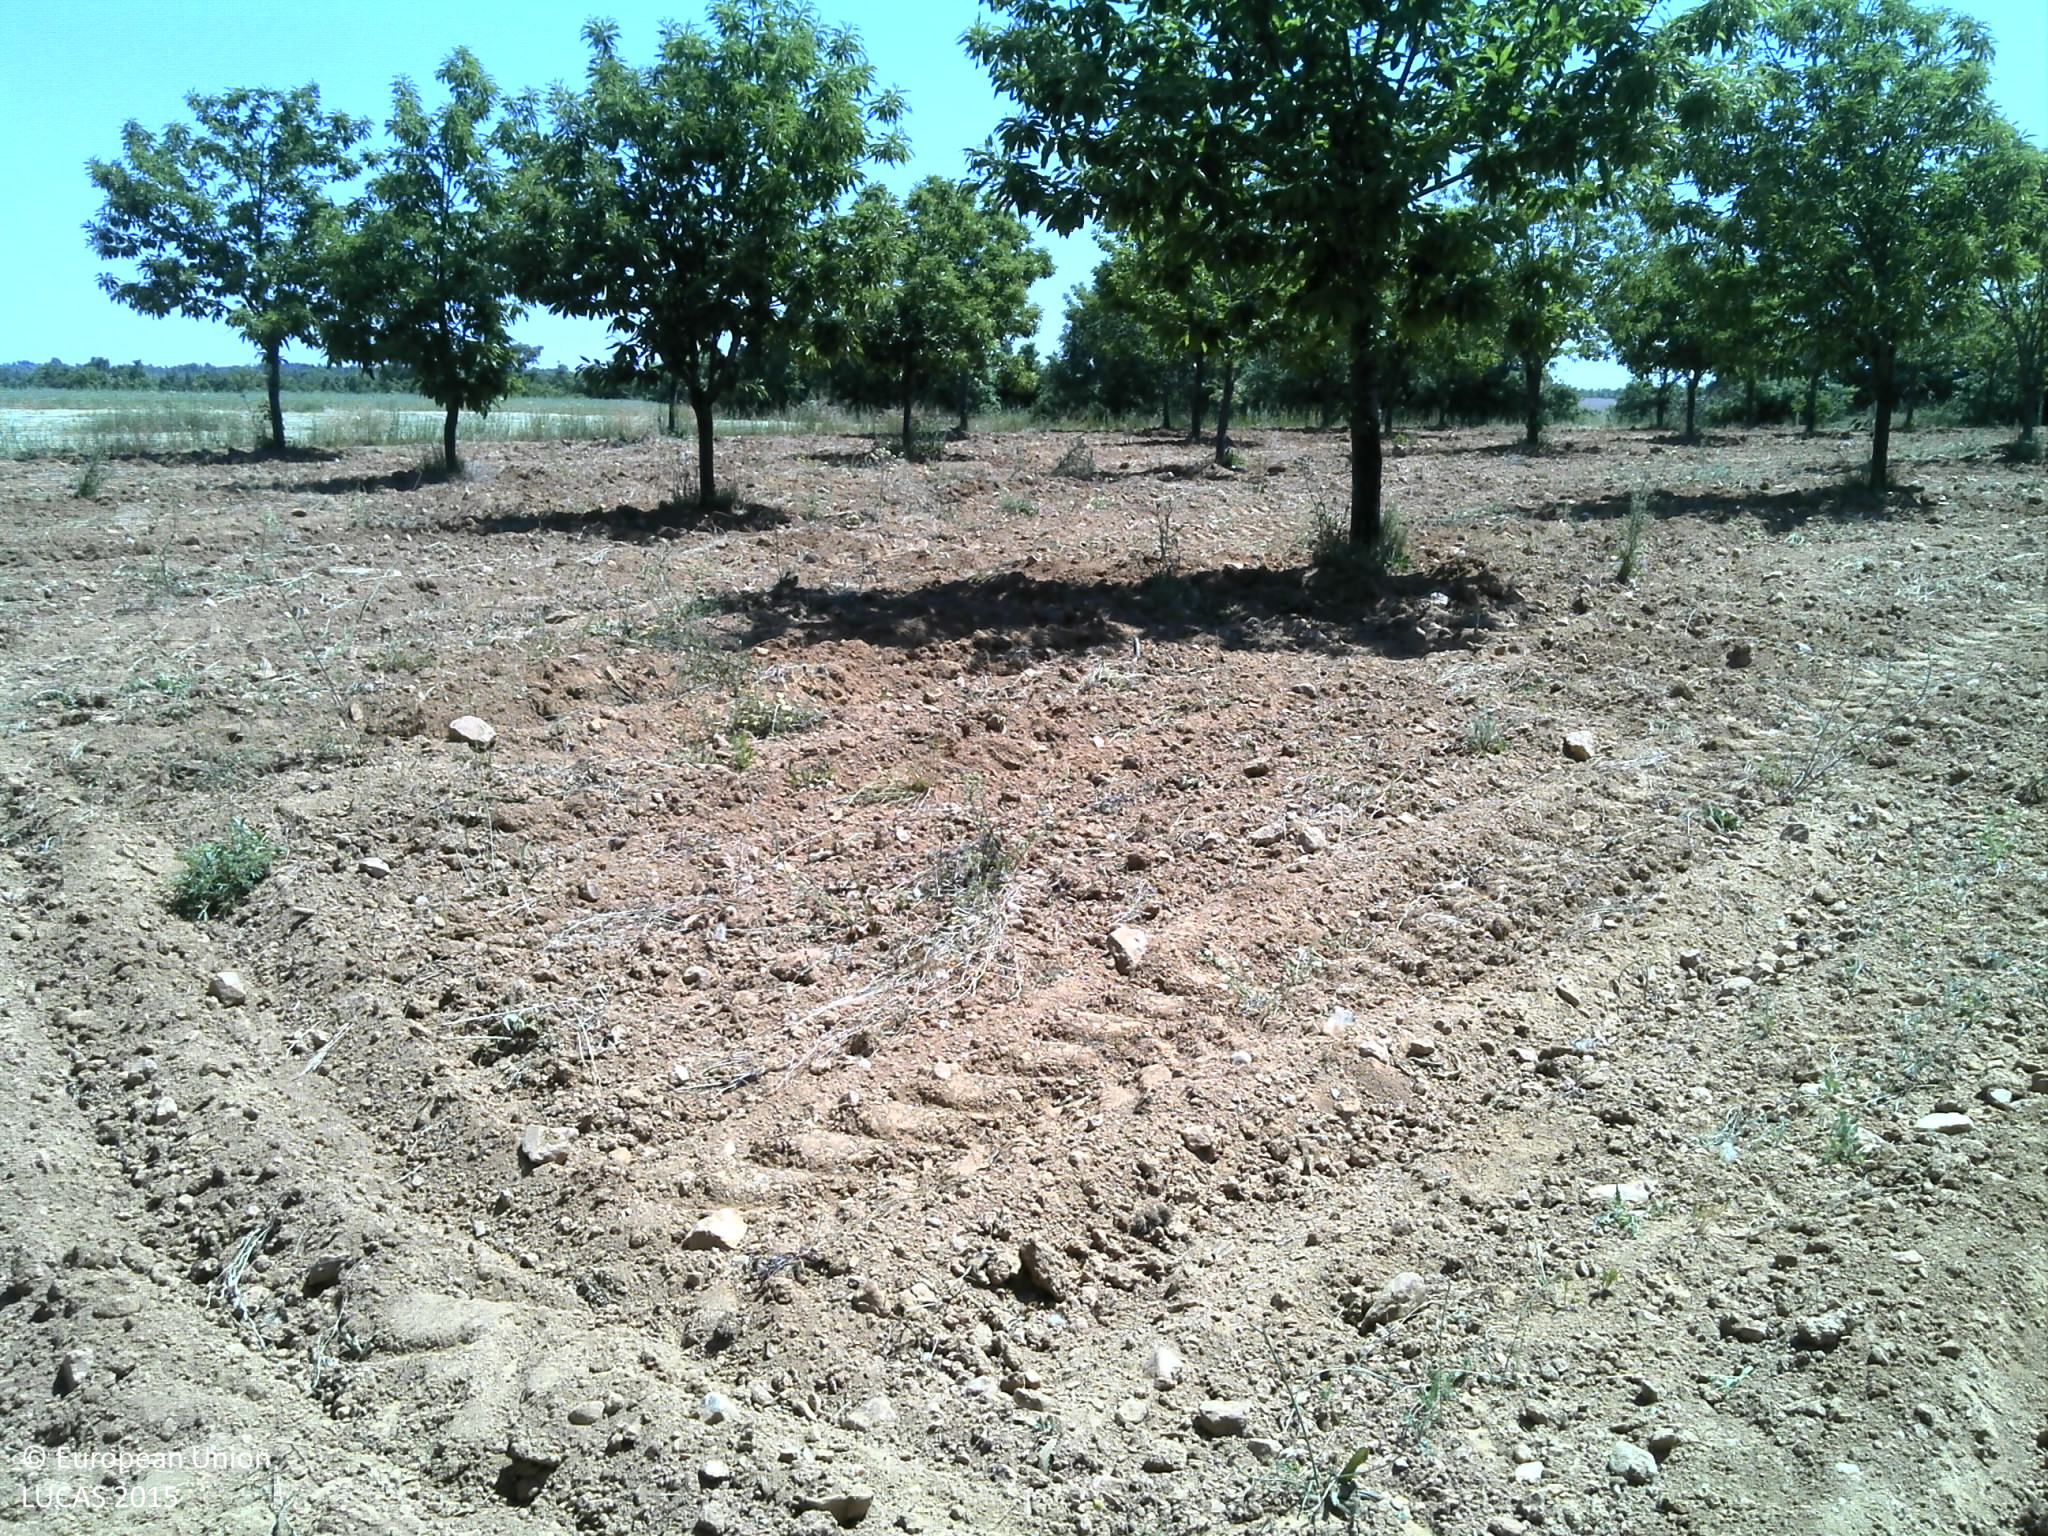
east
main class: Cropland
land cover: Nuts trees
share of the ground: 10 - 25 %
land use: Agriculture (excluding fallow land and kitchen gardens)
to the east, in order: Nuts trees; Lines of trees; Grass margins; Tracks; Grass margins; Abandoned hedges; Spontaneously vegetated surfaces; Grassland with sparse tree/shrub cover; Oats; Grassland with sparse tree/shrub cover; Broadleaved woodland; Spontaneously vegetated surfaces; Other bare soil; Lines of trees; Dry stone walls; Broadleaved woodland
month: May
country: PT
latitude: 41.5293
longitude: -6.3880
